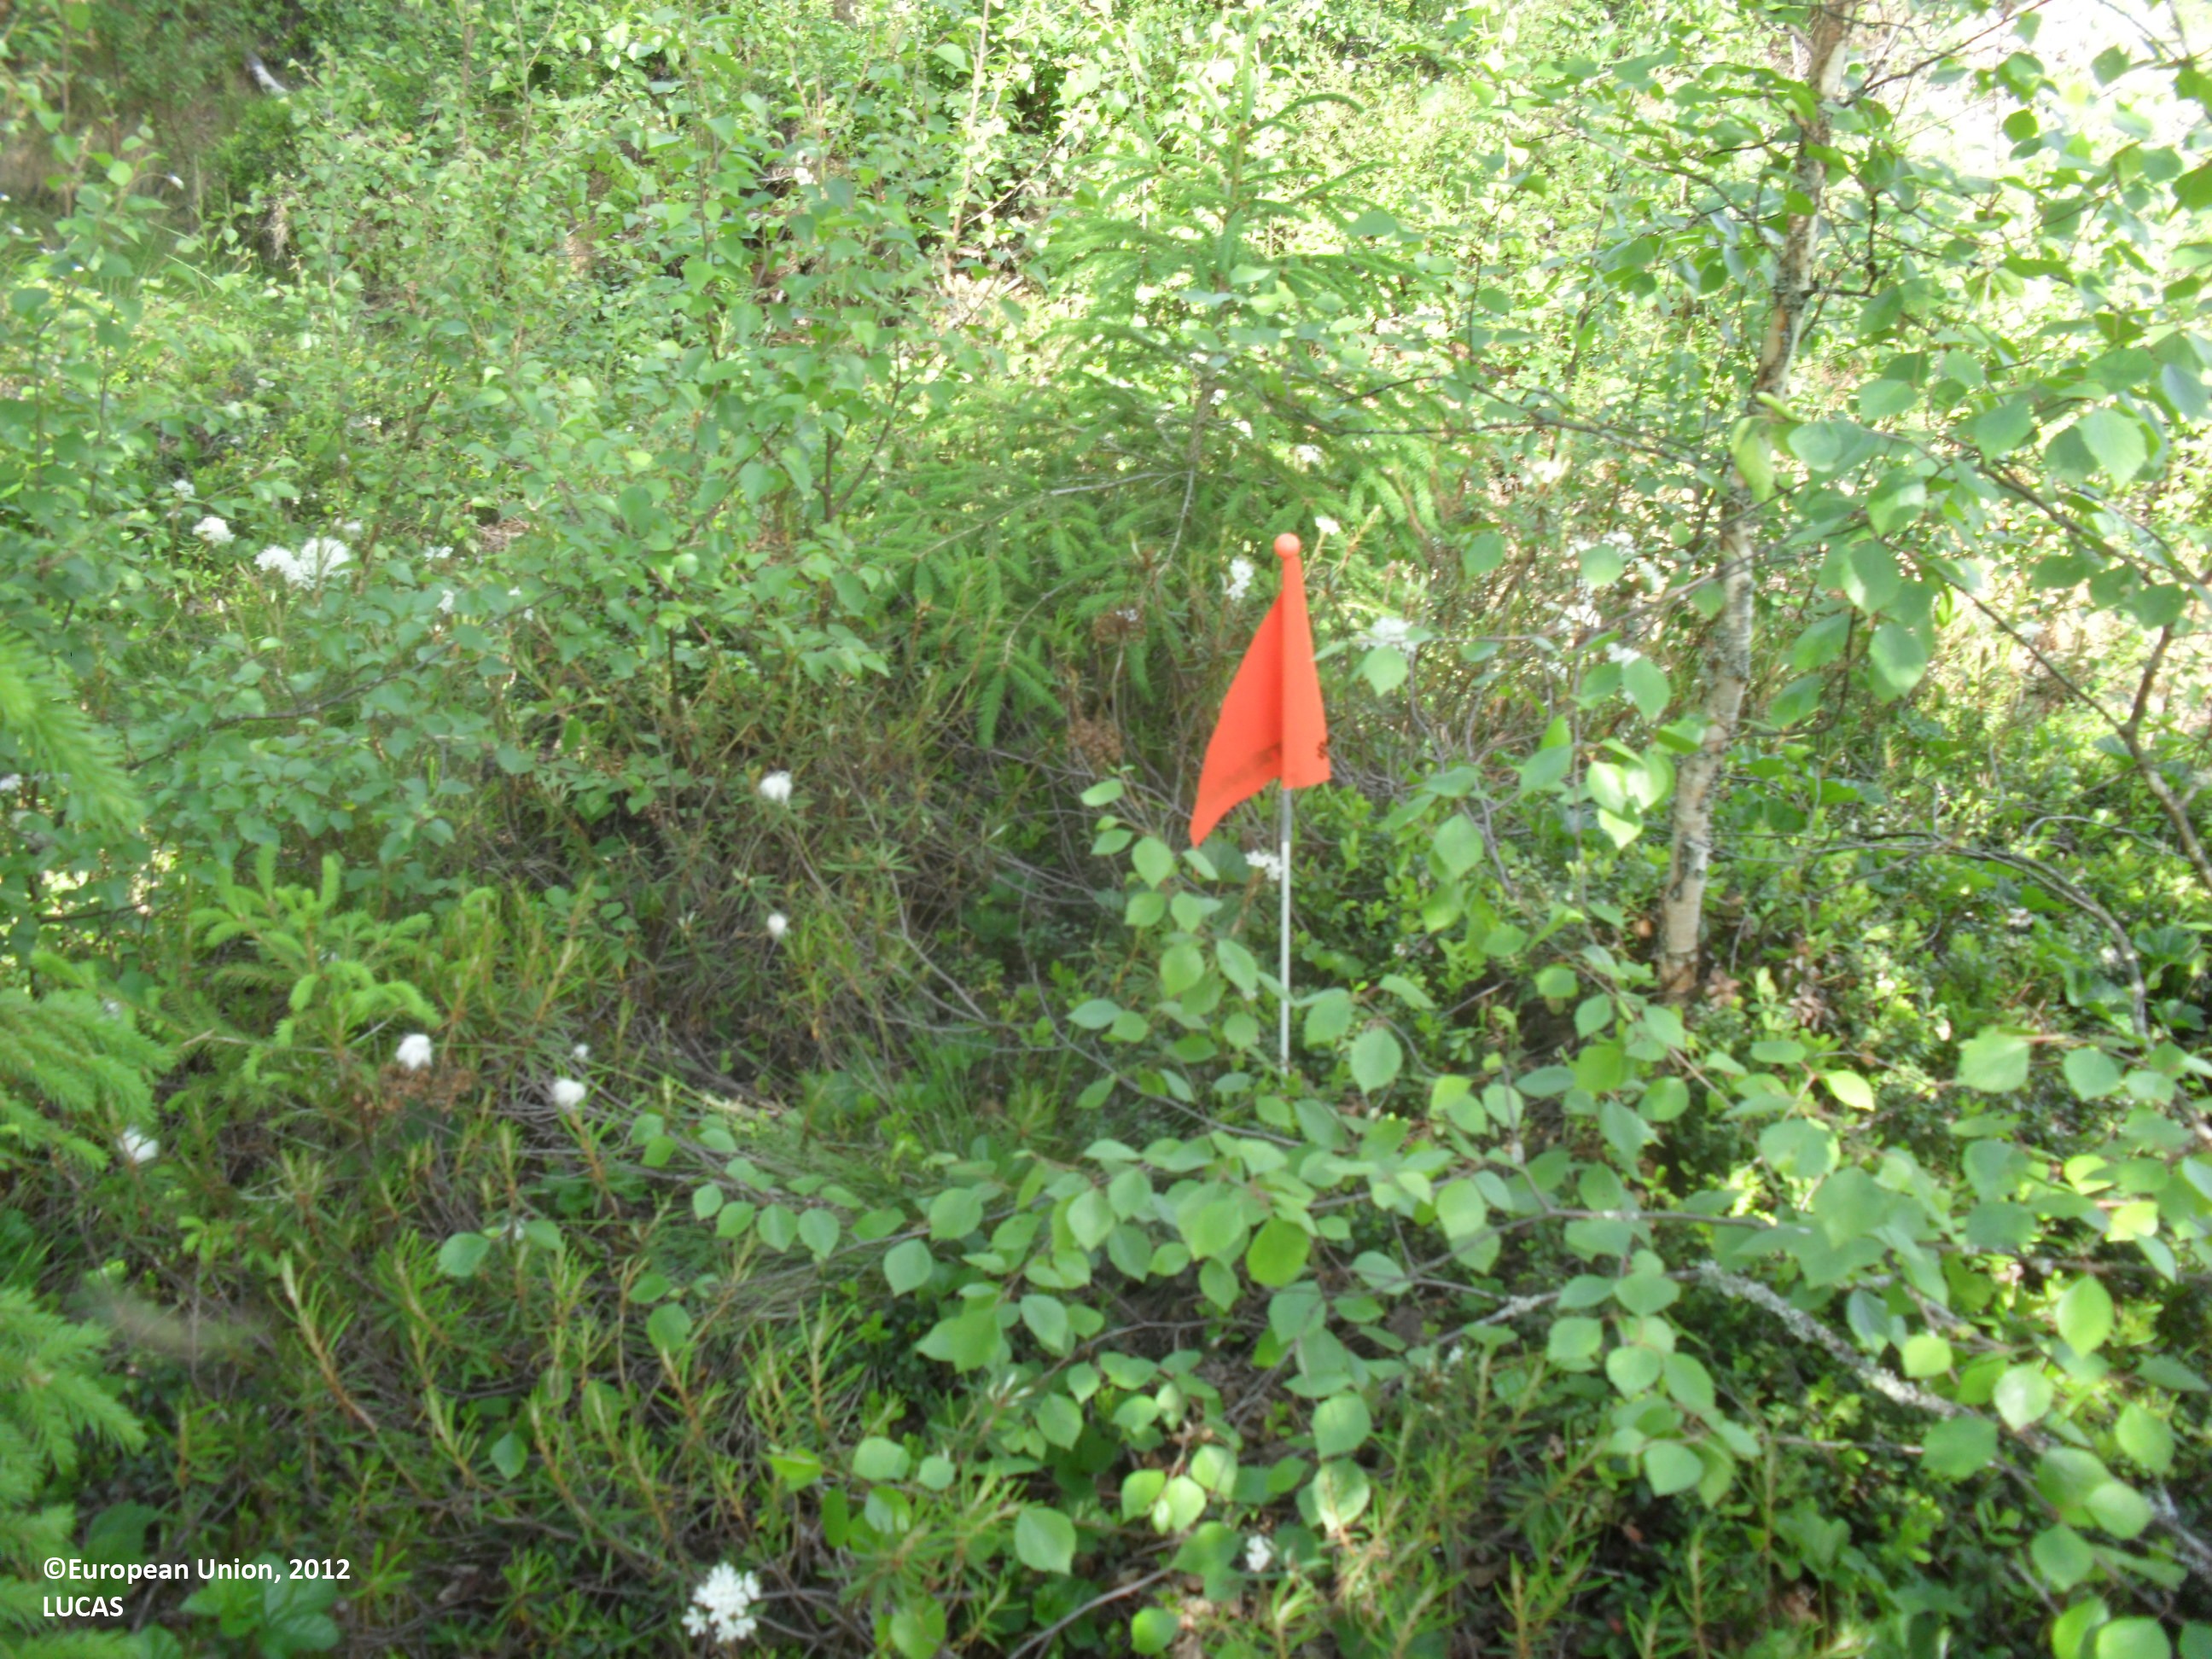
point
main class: Woodland
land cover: Other mixed woodland
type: boreal forest
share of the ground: 25 - 50 %
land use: Forestry
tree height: > 5 m
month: June
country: FI
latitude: 63.3595
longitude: 23.0698
